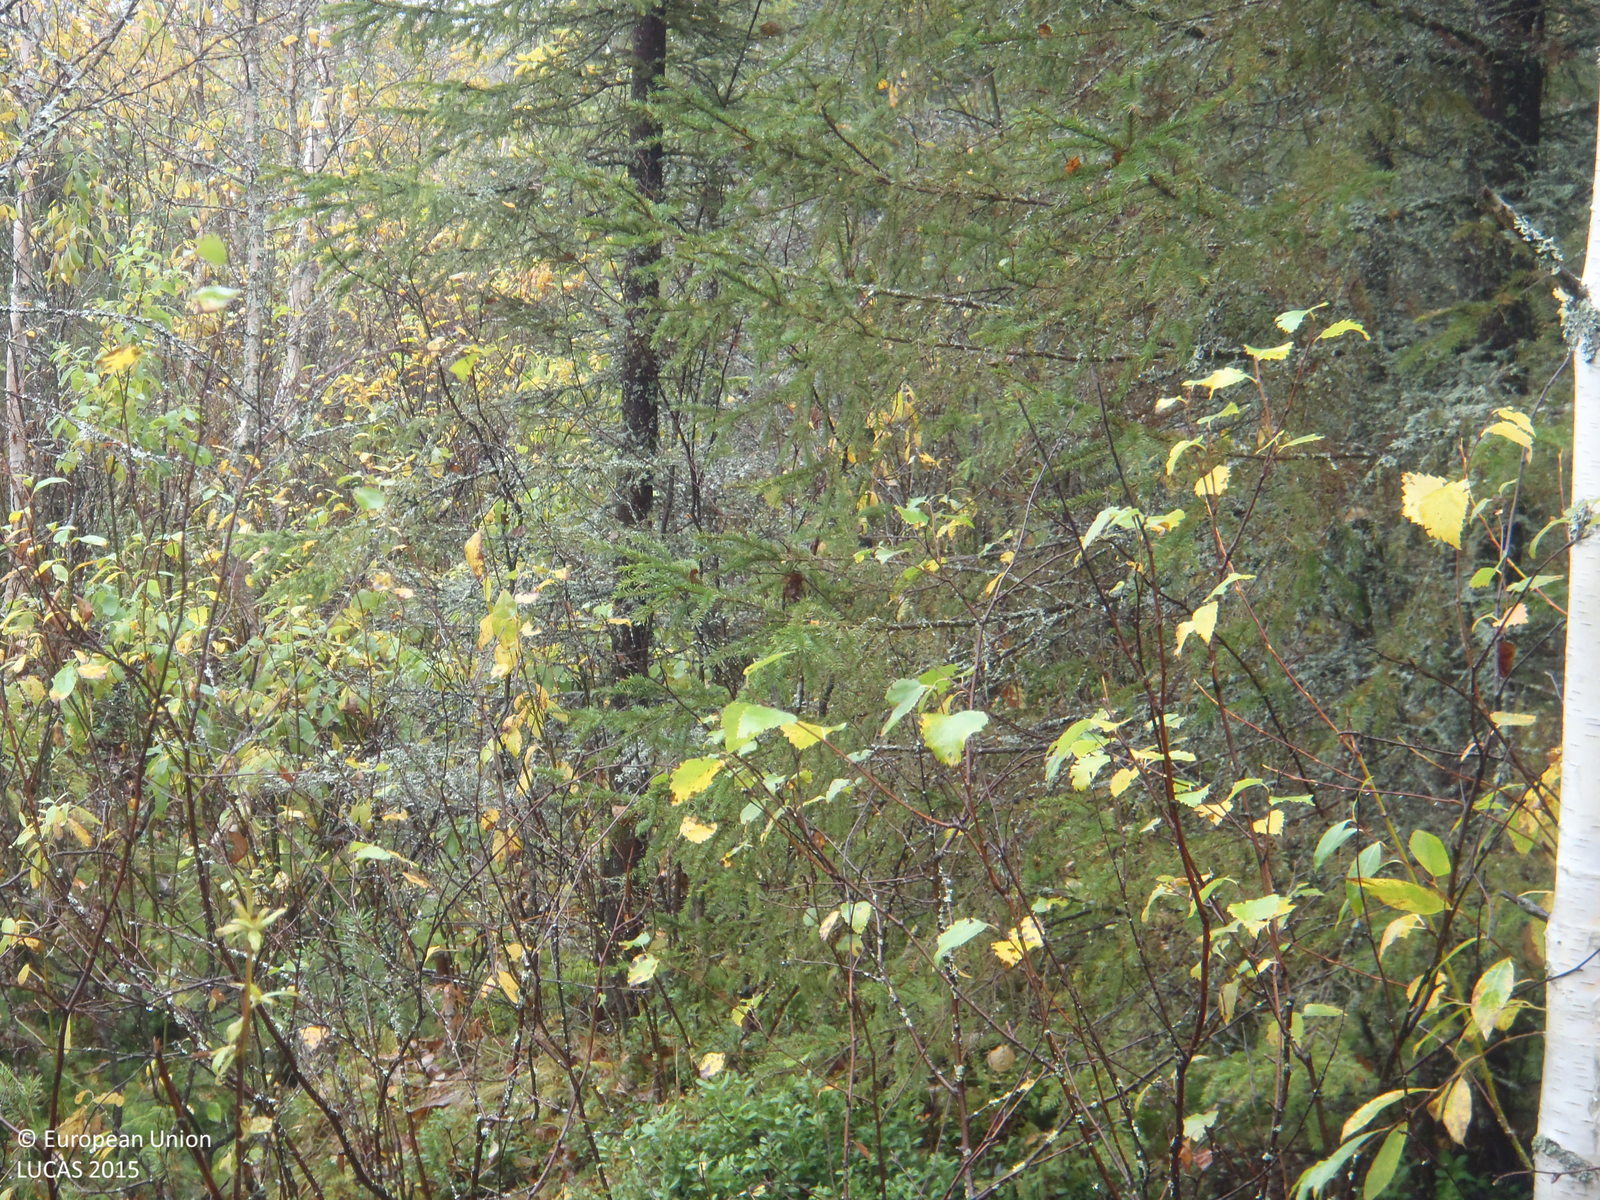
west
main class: Woodland
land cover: Spruce dominated coniferous woodland
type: boreal forest
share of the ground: > 75 %
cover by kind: coniferous forest trees 70 %, broadleaved forest trees 20 %, shrubs 5 %, herbaceous plants 5 %
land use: Forestry
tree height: > 5 m
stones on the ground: < 10 %
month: September
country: FI
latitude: 65.1569
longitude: 26.5104
